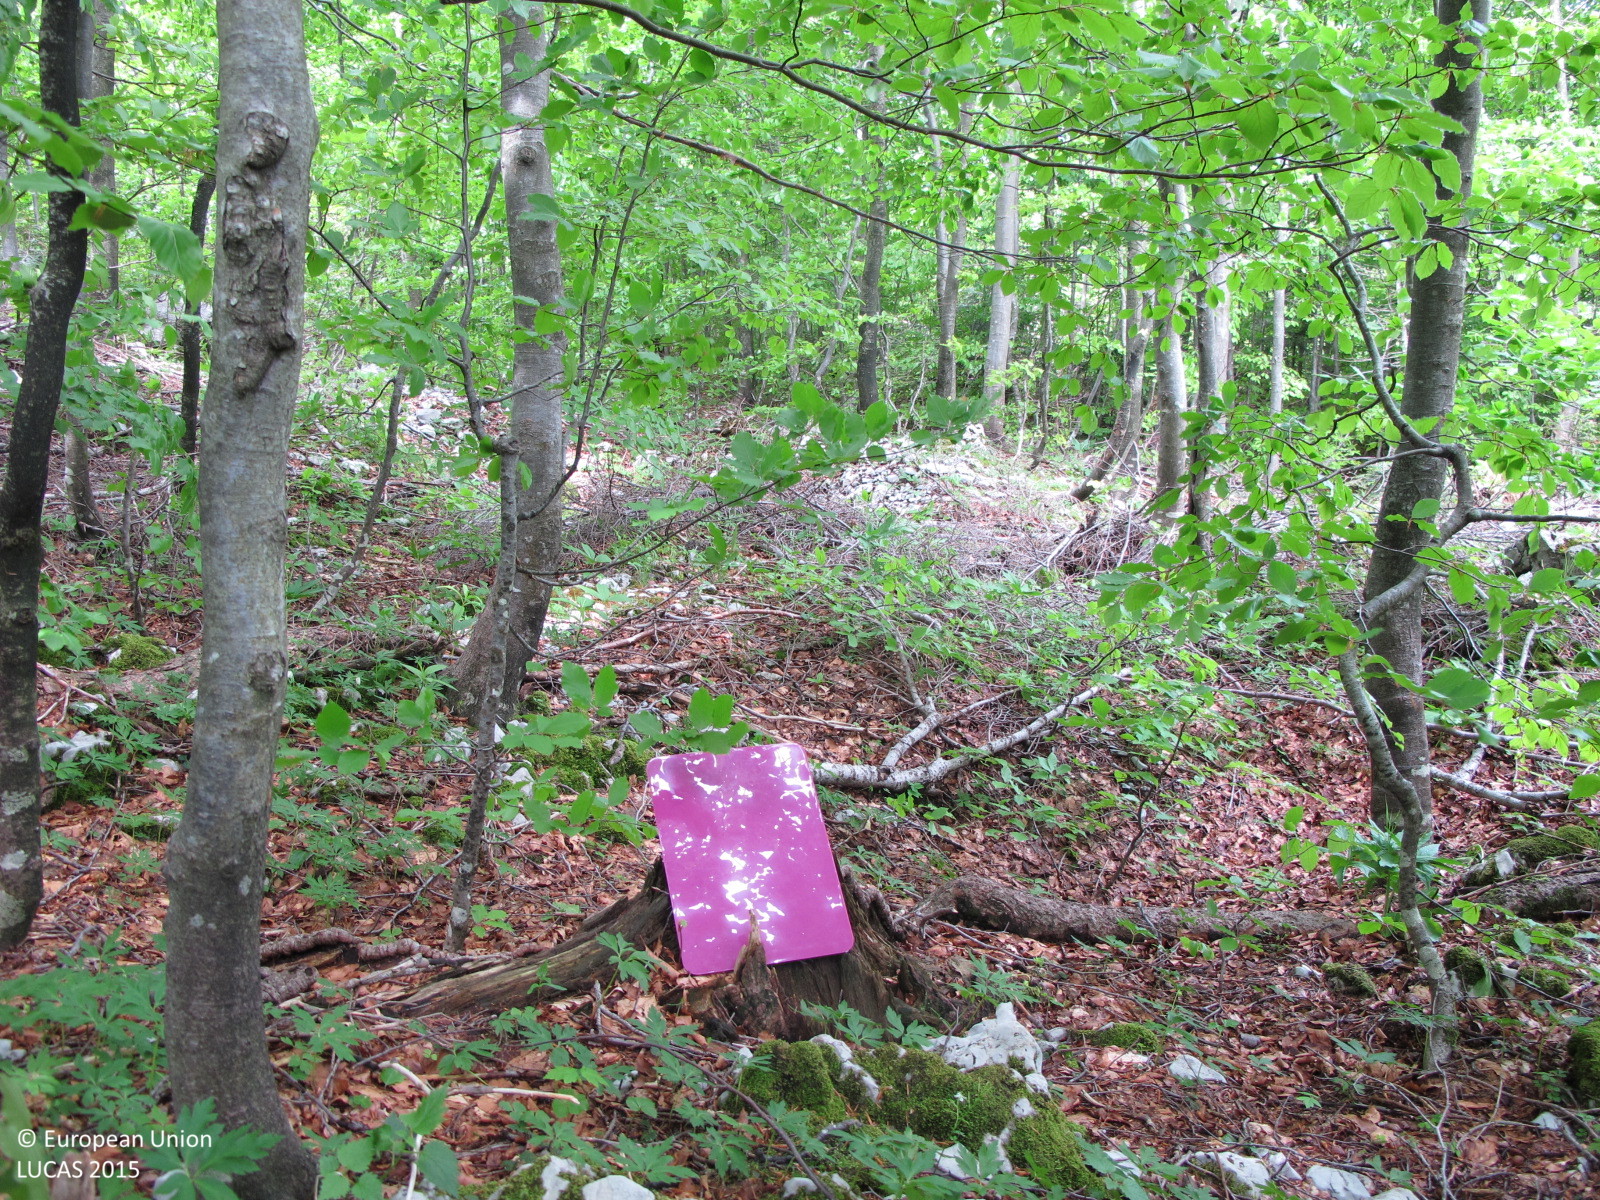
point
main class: Woodland
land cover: Broadleaved woodland
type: mountainous beech forest
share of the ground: > 75 %
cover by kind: broadleaved forest trees 80 %, coniferous forest trees 5 %, shrubs 5 %, herbaceous plants 5 %, consolidated bare surface 5 %
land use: Forestry
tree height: > 5 m
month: May
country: HR
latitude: 45.4421
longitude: 14.5593
